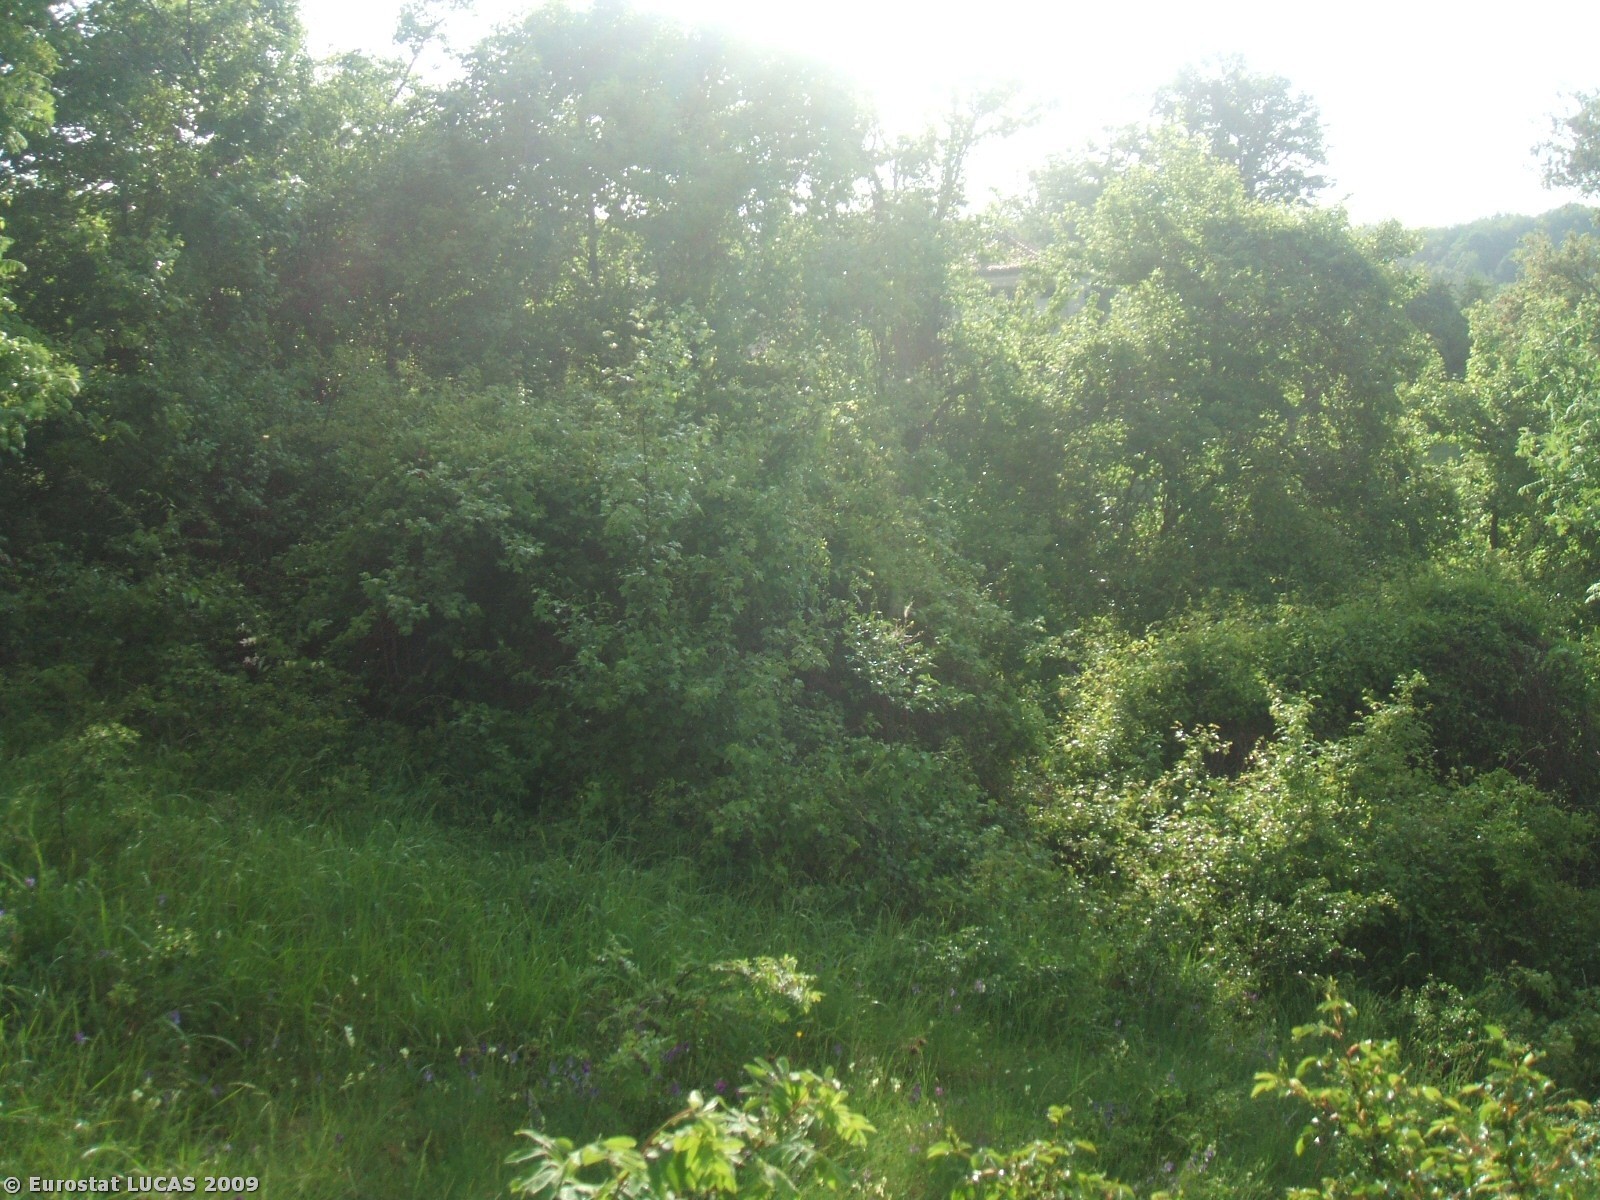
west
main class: Shrubland
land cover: Shrubland with sparse tree cover
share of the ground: > 75 %
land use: Fallow land
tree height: < 5 m
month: May
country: IT
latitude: 40.2772
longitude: 15.7975
